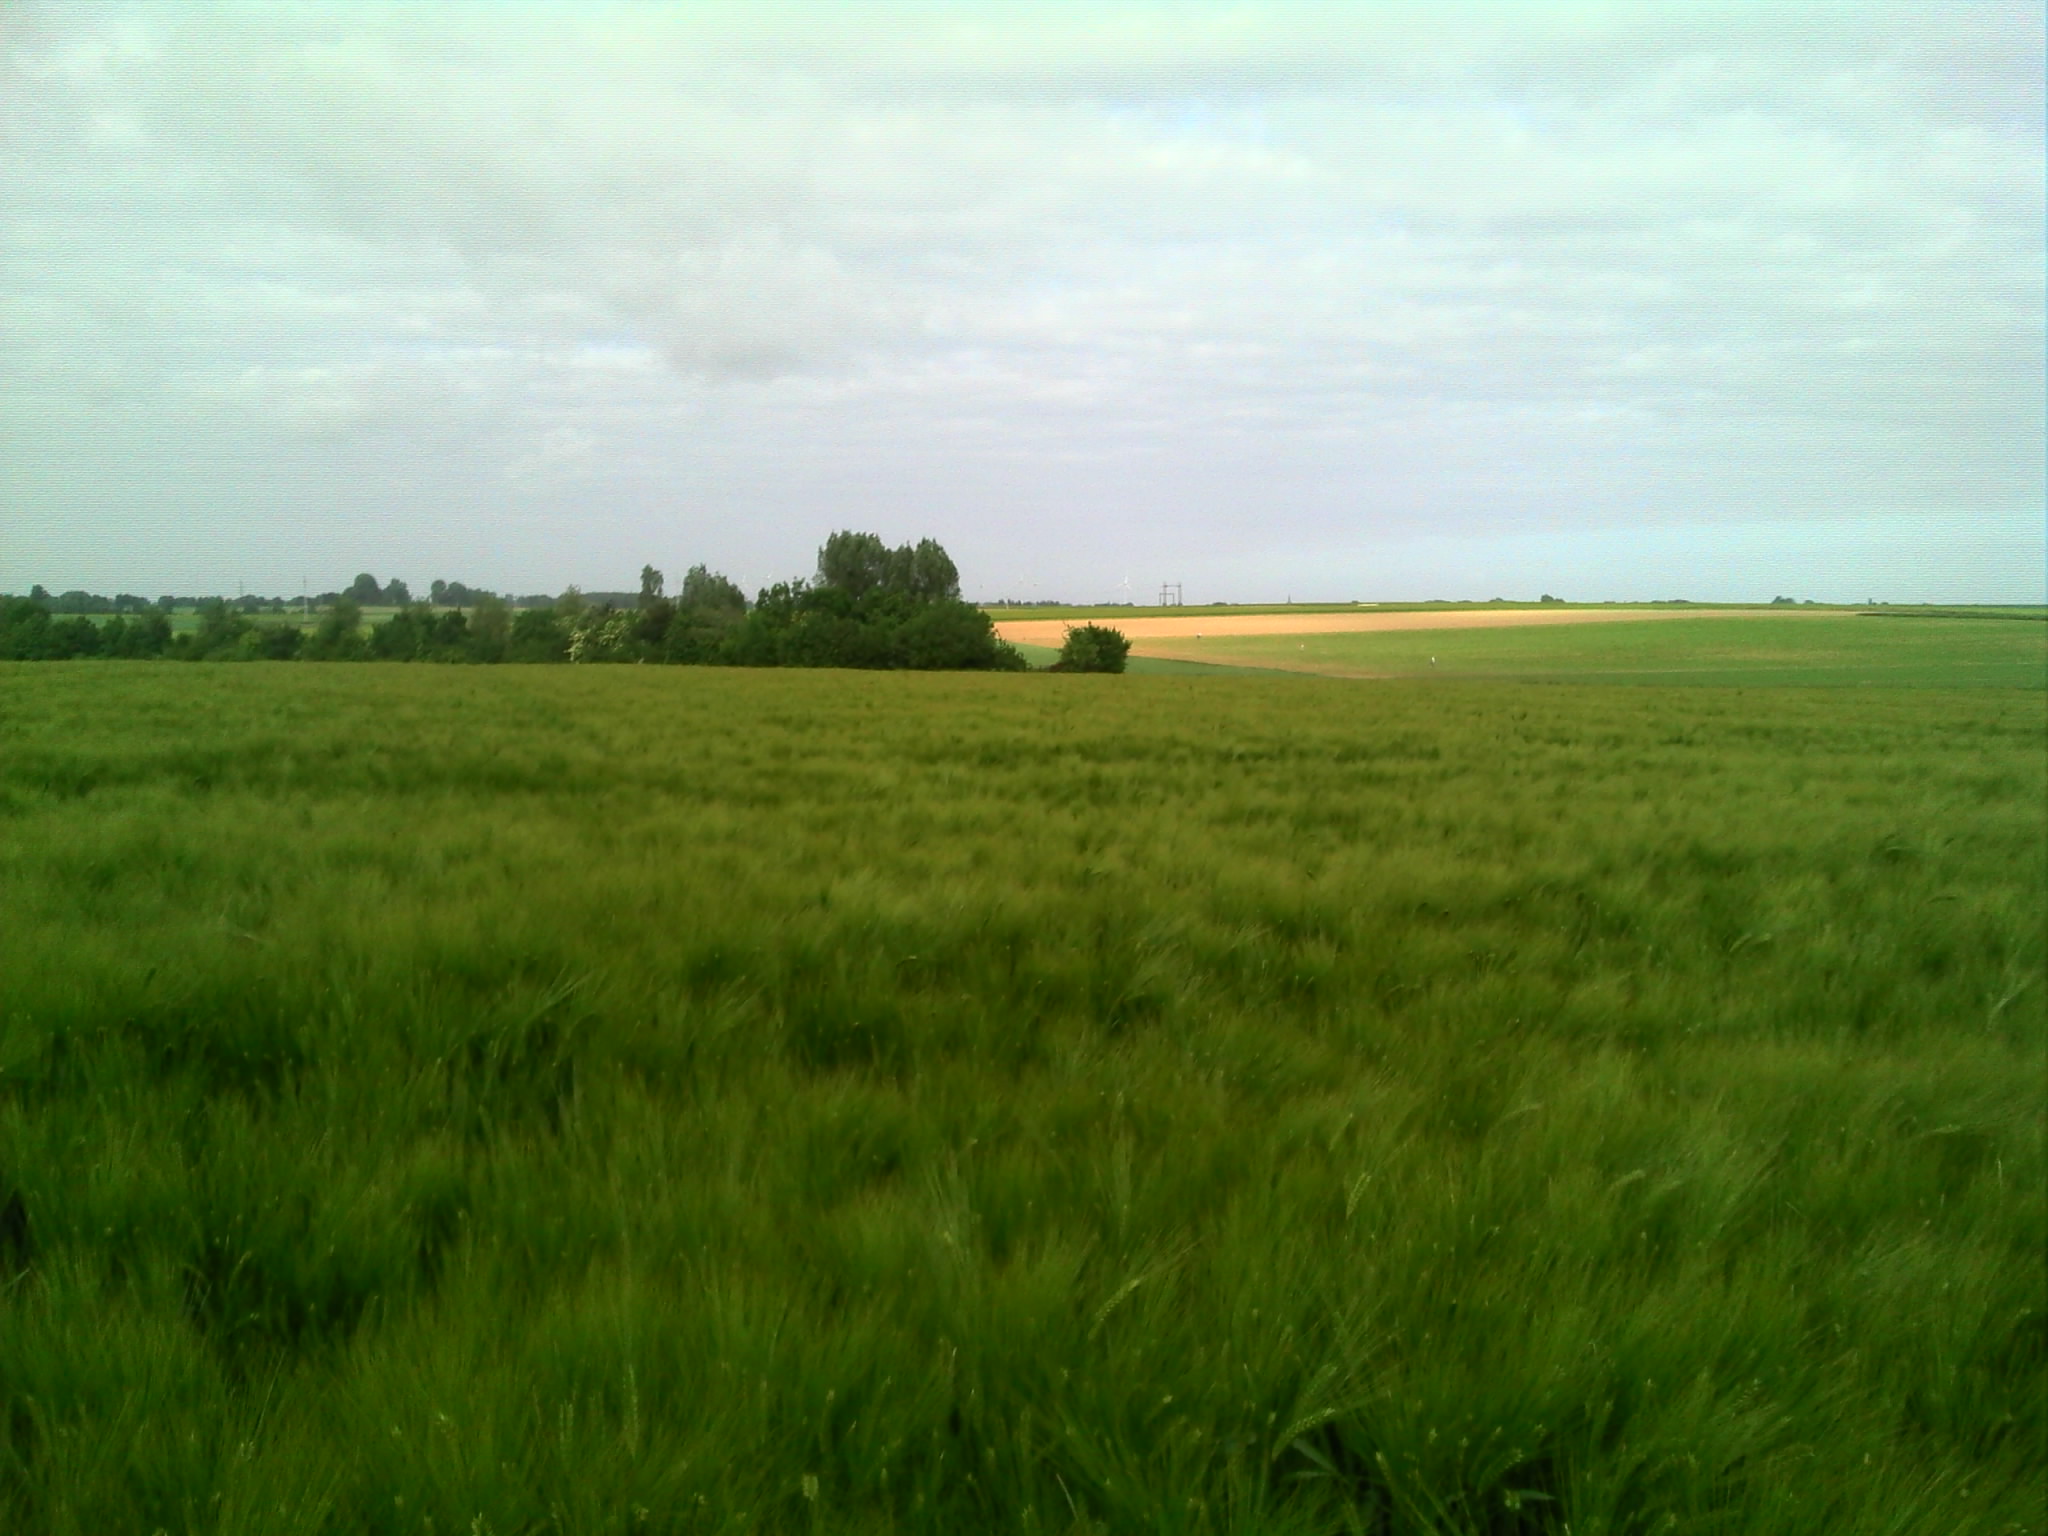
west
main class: Cropland
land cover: Barley
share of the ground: > 75 %
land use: Agriculture (excluding fallow land and kitchen gardens)
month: June
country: BE
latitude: 50.5425
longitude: 4.5916
